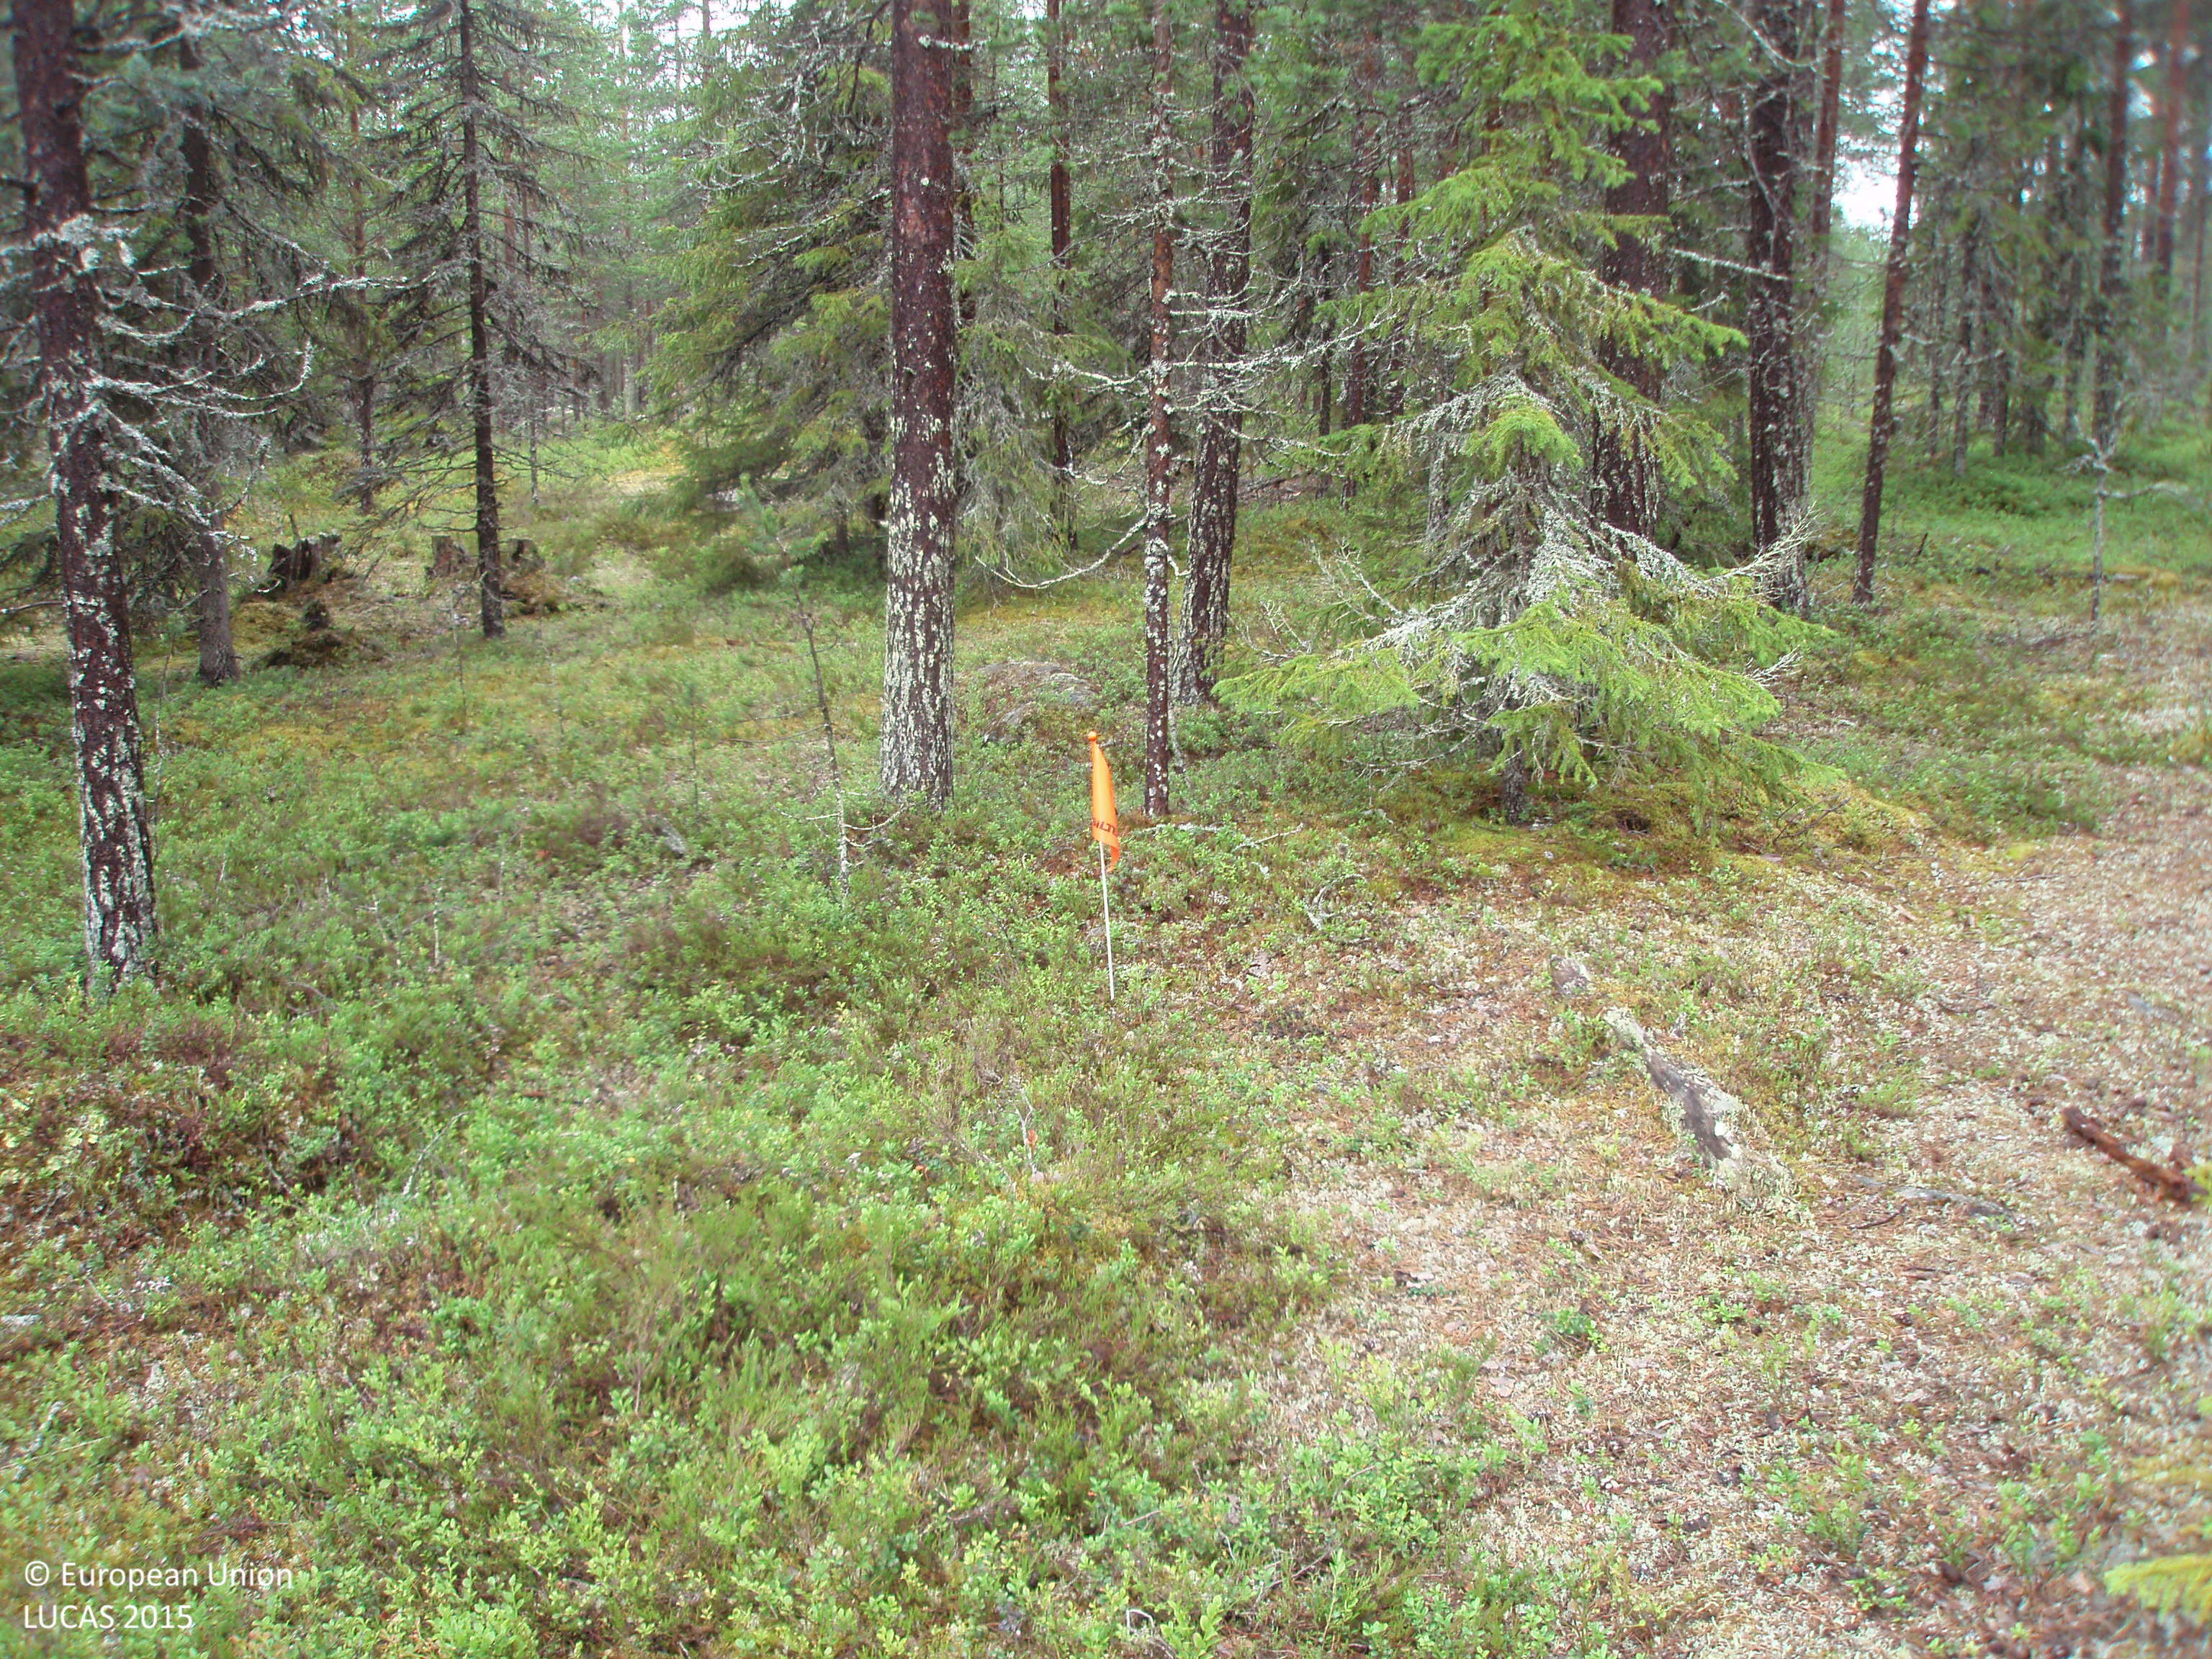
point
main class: Woodland
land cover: Pine dominated coniferous woodland
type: boreal forest
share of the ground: 50 - 75 %
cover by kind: coniferous forest trees 70 %, shrubs 30 %
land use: Forestry
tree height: > 5 m
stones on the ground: 25 - 50 %
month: July
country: FI
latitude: 66.0339
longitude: 28.0762
